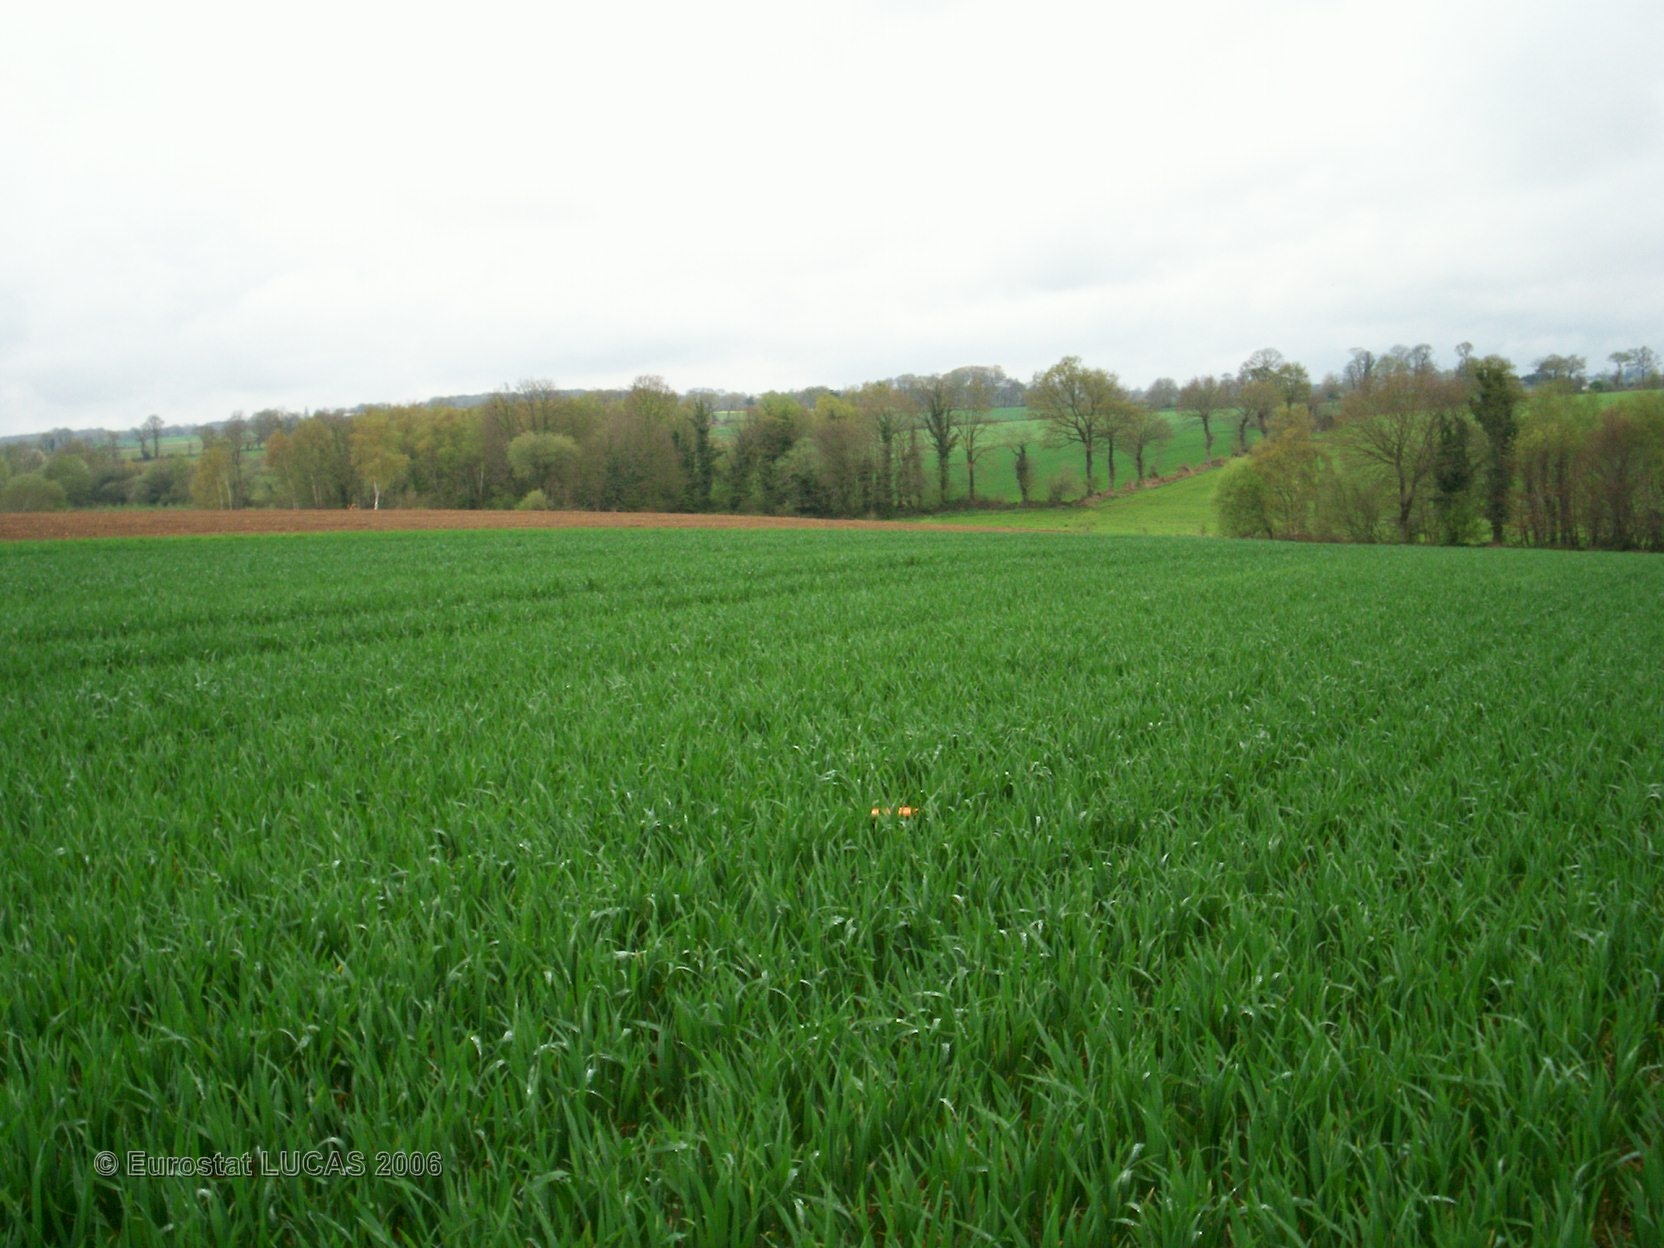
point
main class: Cropland
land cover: Triticale
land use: Agriculture (excluding fallow land and kitchen gardens)
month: April
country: FR
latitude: 48.1706
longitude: -2.4440
